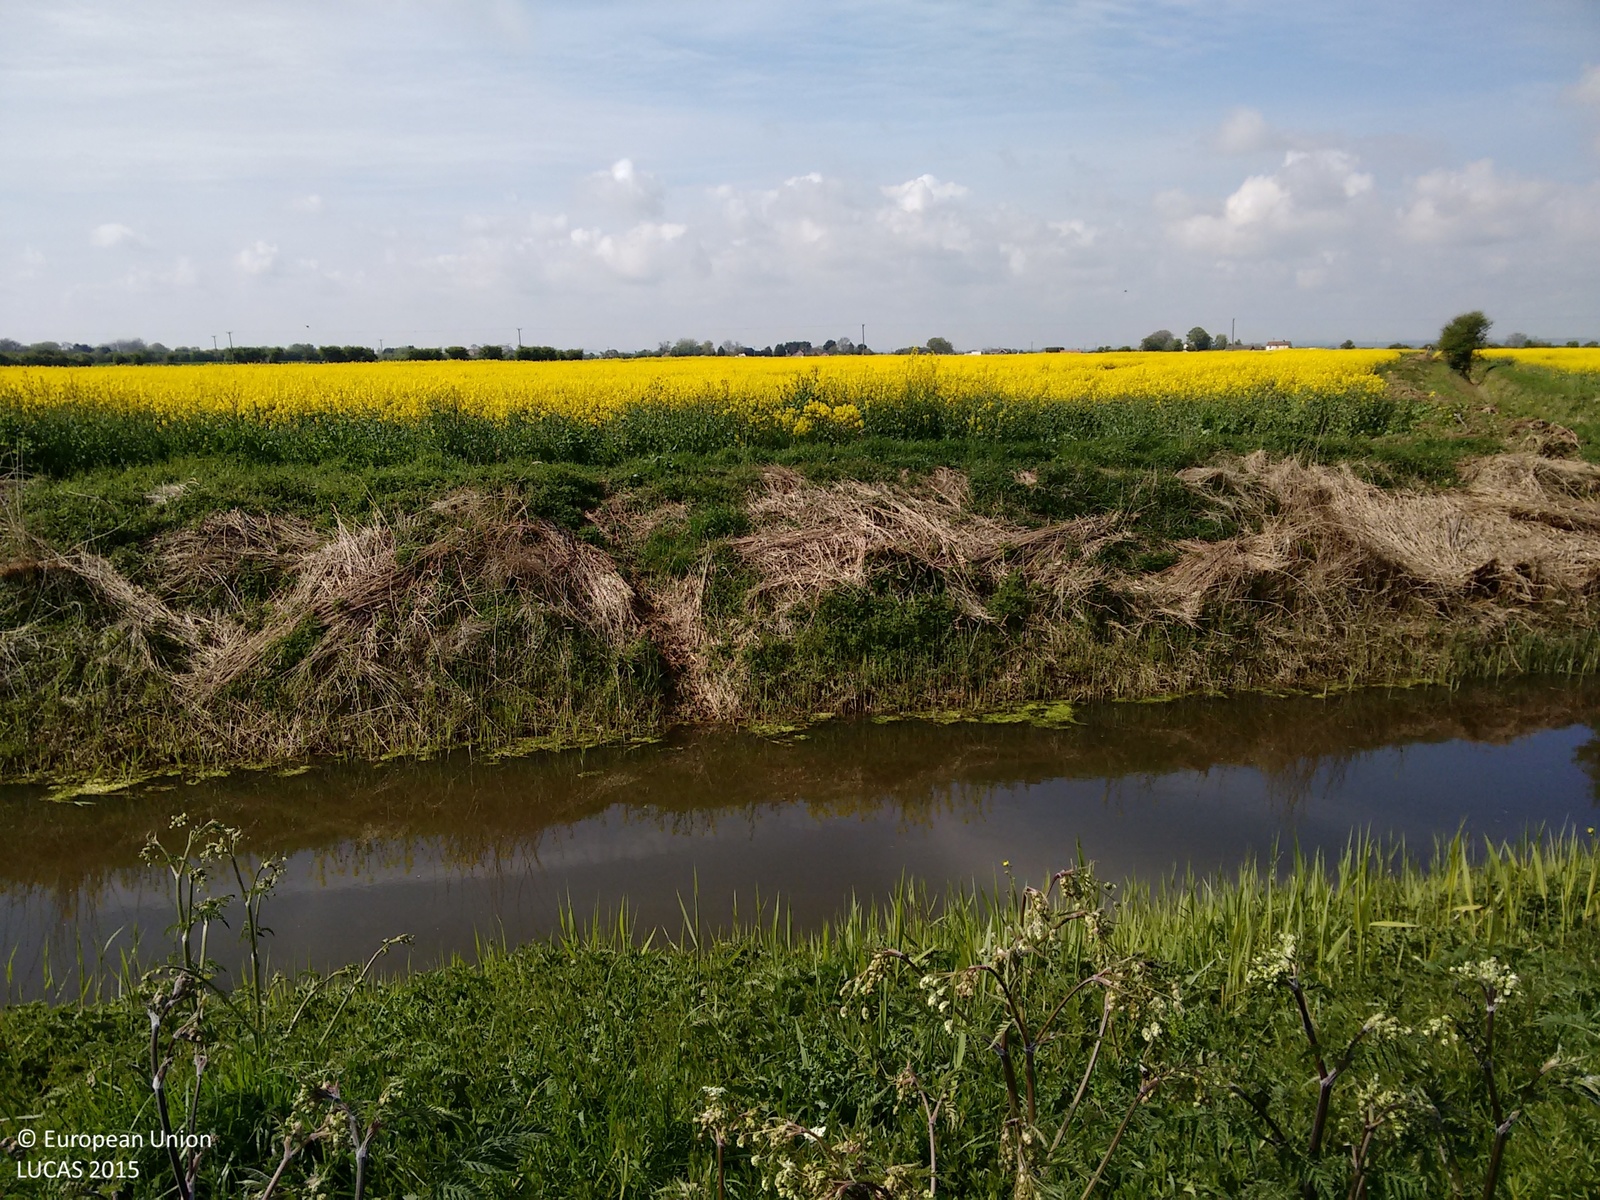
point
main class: Cropland
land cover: Rape and turnip rape
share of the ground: > 75 %
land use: Agriculture (excluding fallow land and kitchen gardens)
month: May
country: GB
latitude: 53.3672
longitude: 0.2169
